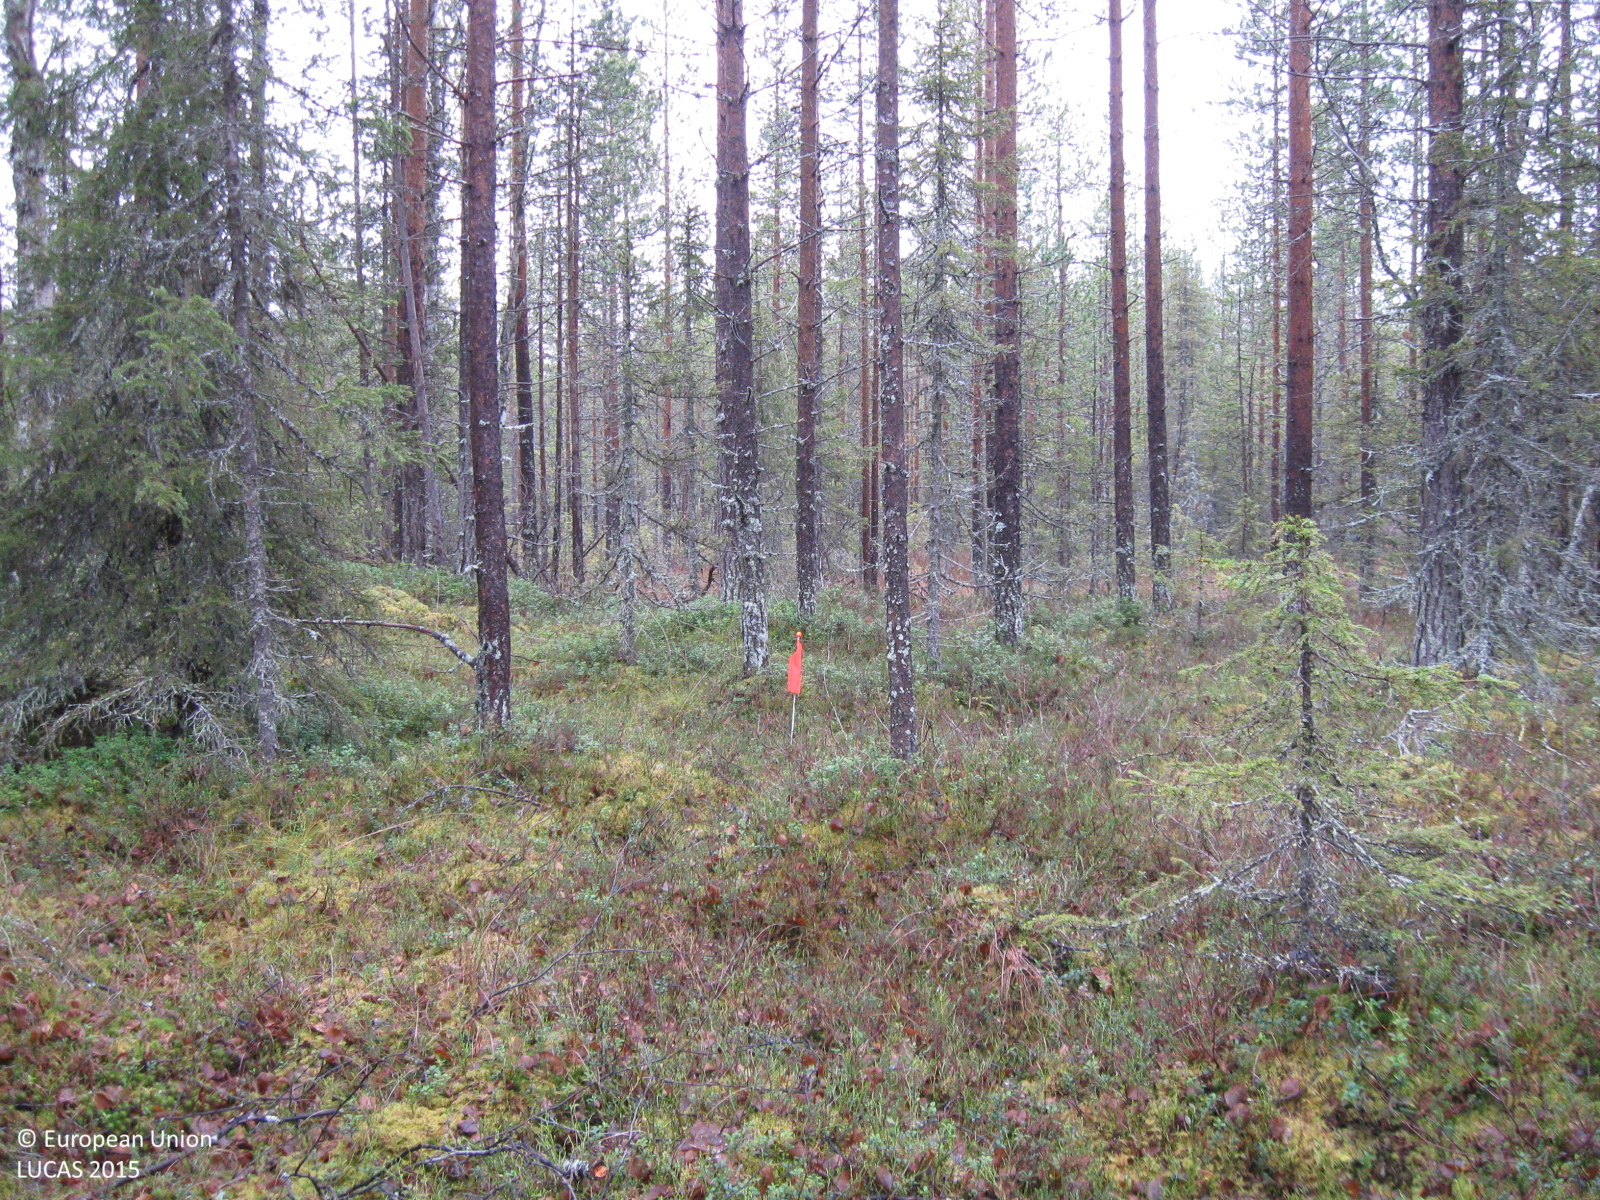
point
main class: Woodland
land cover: Other coniferous woodland
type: boreal forest
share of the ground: > 75 %
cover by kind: coniferous forest trees 70 %, broadleaved forest trees 10 %, shrubs 10 %, herbaceous plants 5 %, lichens and mosses 5 %
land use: Forestry
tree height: > 5 m
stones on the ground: 10 - 25 %
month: October
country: SE
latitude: 66.6926
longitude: 21.7167
